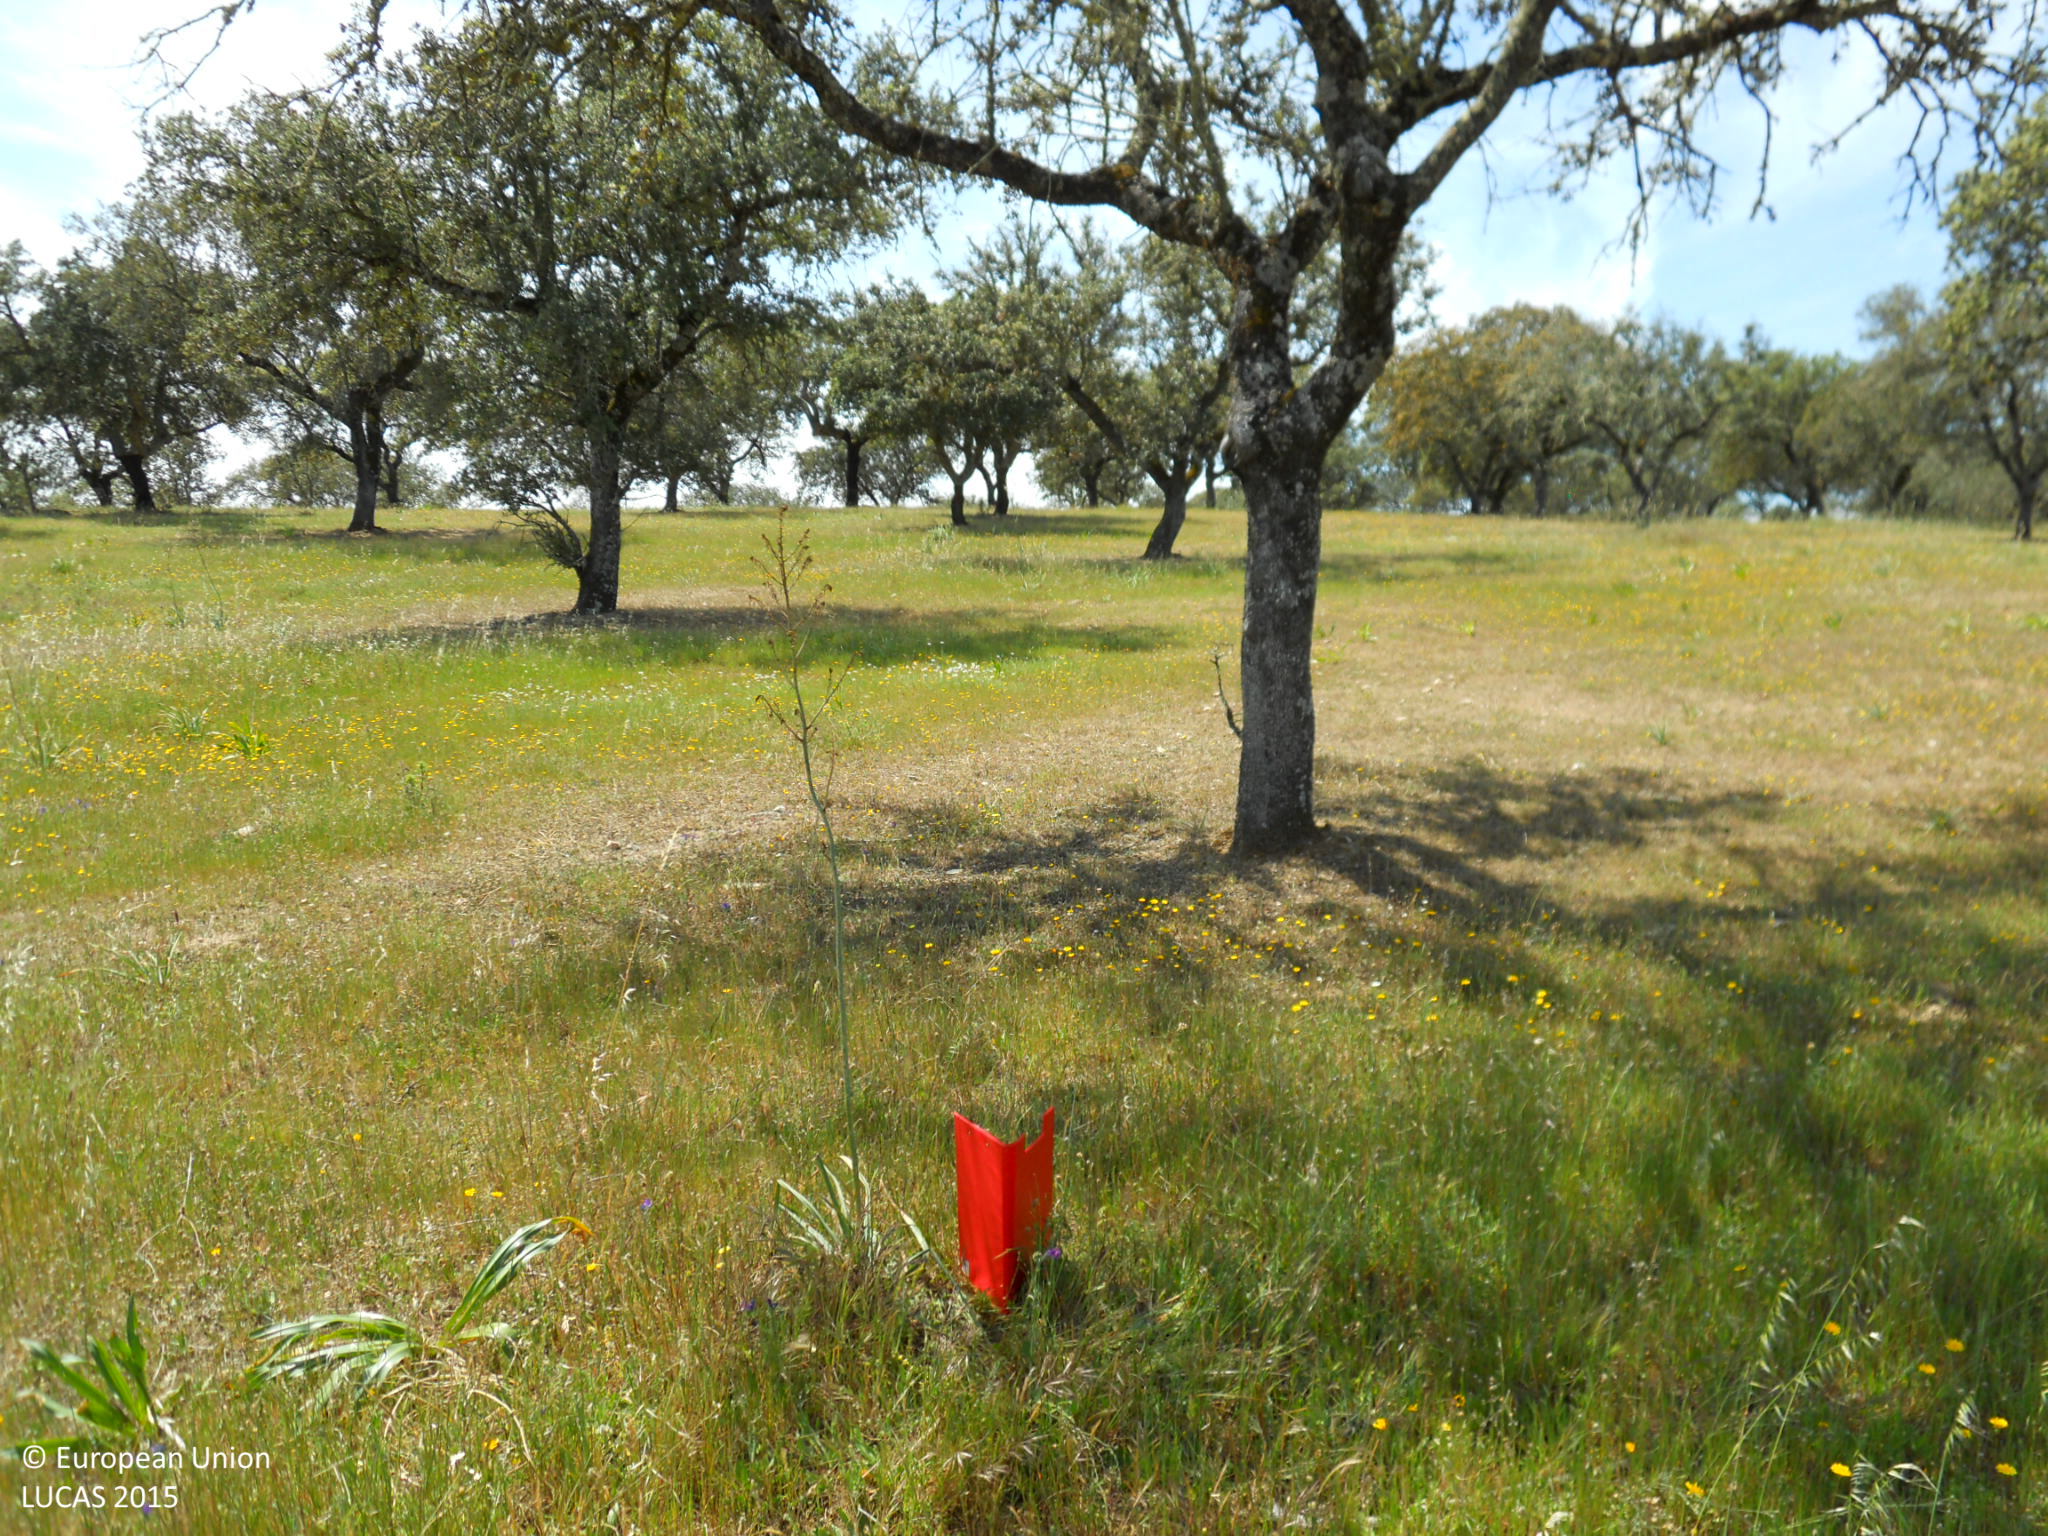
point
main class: Woodland
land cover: Broadleaved woodland
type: broadleaved evergreen forest
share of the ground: 10 - 25 %
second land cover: Grassland without tree/shrub cover
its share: > 75 %
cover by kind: herbaceous plants 70 %, broadleaved forest trees 20 %, unconsolidated bare surface 10 %
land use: Forestry
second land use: Agriculture (excluding fallow land and kitchen gardens)
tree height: > 5 m
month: April
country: ES
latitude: 39.3634
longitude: -6.9894
